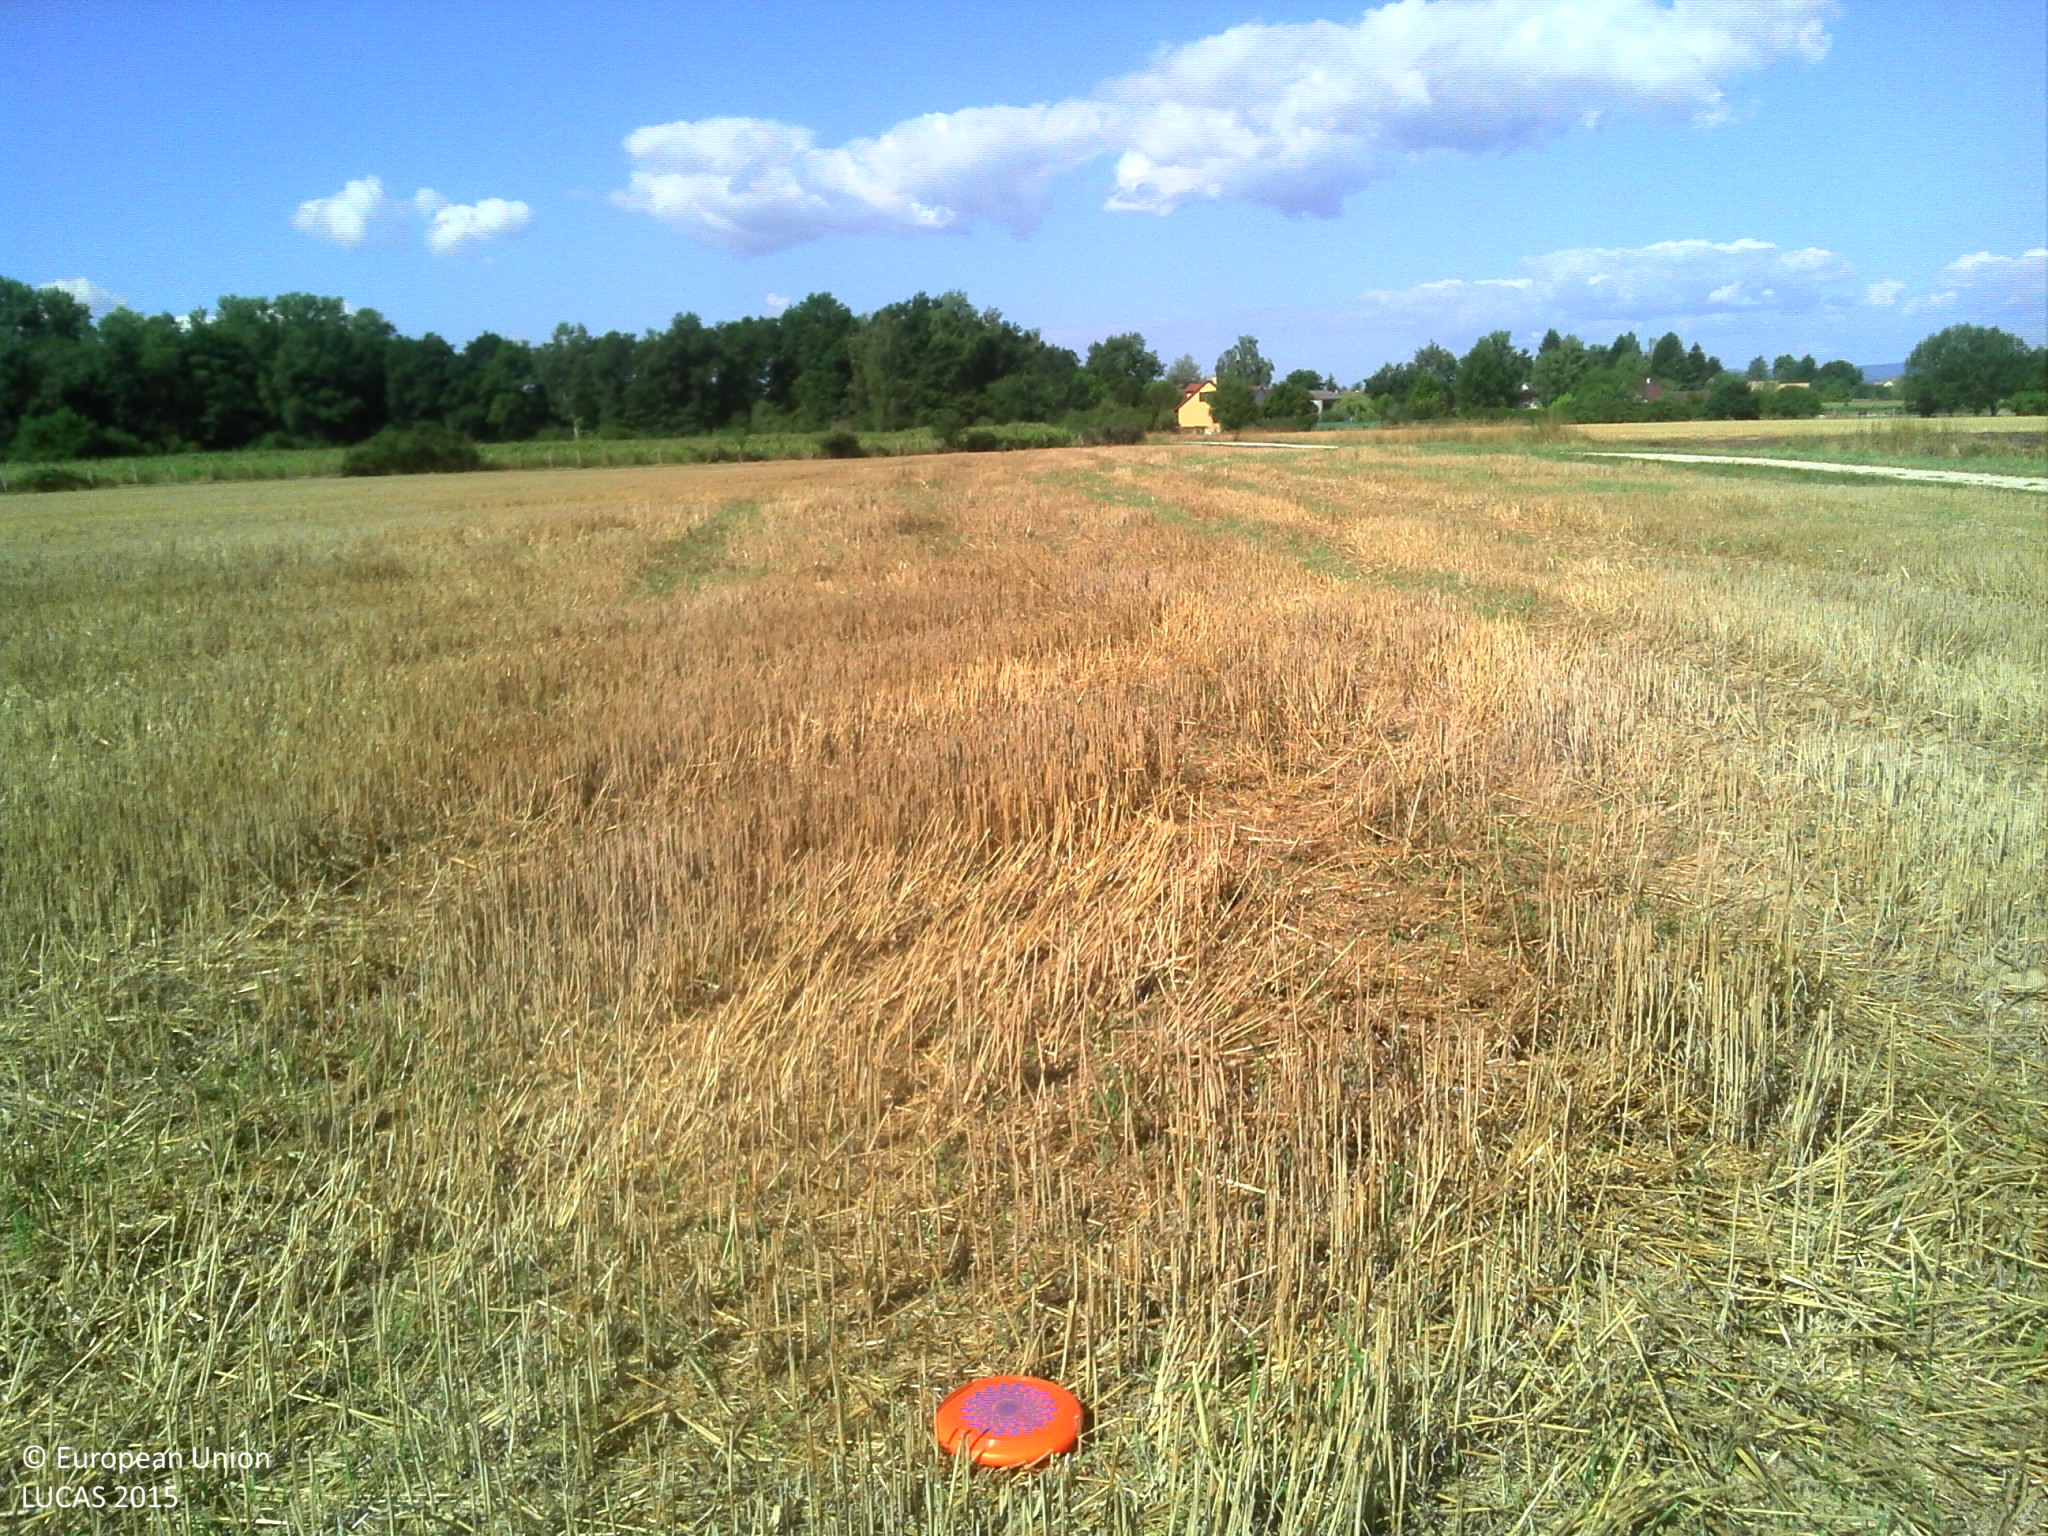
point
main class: Cropland
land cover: Common wheat
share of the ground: > 75 %
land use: Agriculture (excluding fallow land and kitchen gardens)
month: July
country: FR
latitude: 46.7725
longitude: 4.9334
